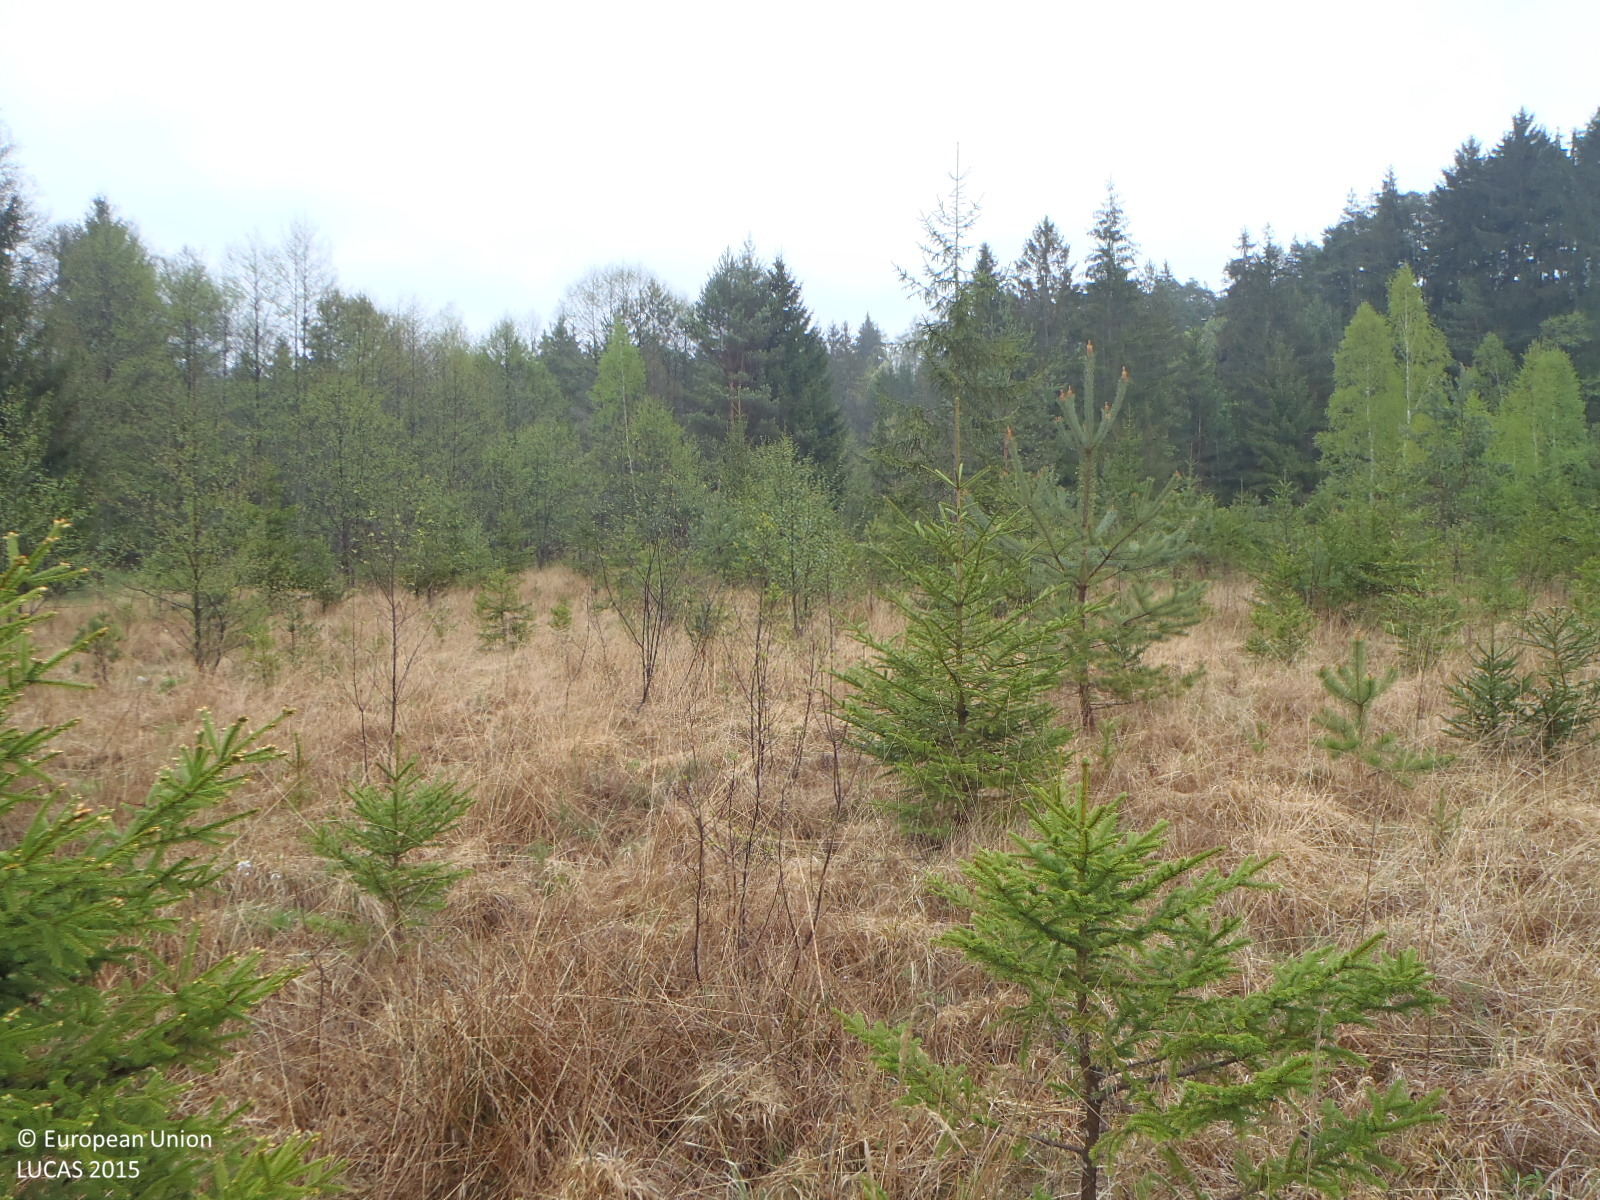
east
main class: Woodland
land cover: Spruce dominated coniferous woodland
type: mire and swamp forests
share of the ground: 25 - 50 %
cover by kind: herbaceous plants 70 %, coniferous forest trees 25 %, broadleaved forest trees 5 %
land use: Abandoned areas
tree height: > 5 m
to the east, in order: Spruce dominated coniferous woodland; Other mixed woodland; Electric lines; Broadleaved woodland; Grassland without tree/shrub cover; Other mixed woodland; Spruce dominated coniferous woodland
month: May
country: CZ
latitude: 49.2067
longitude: 15.0673
